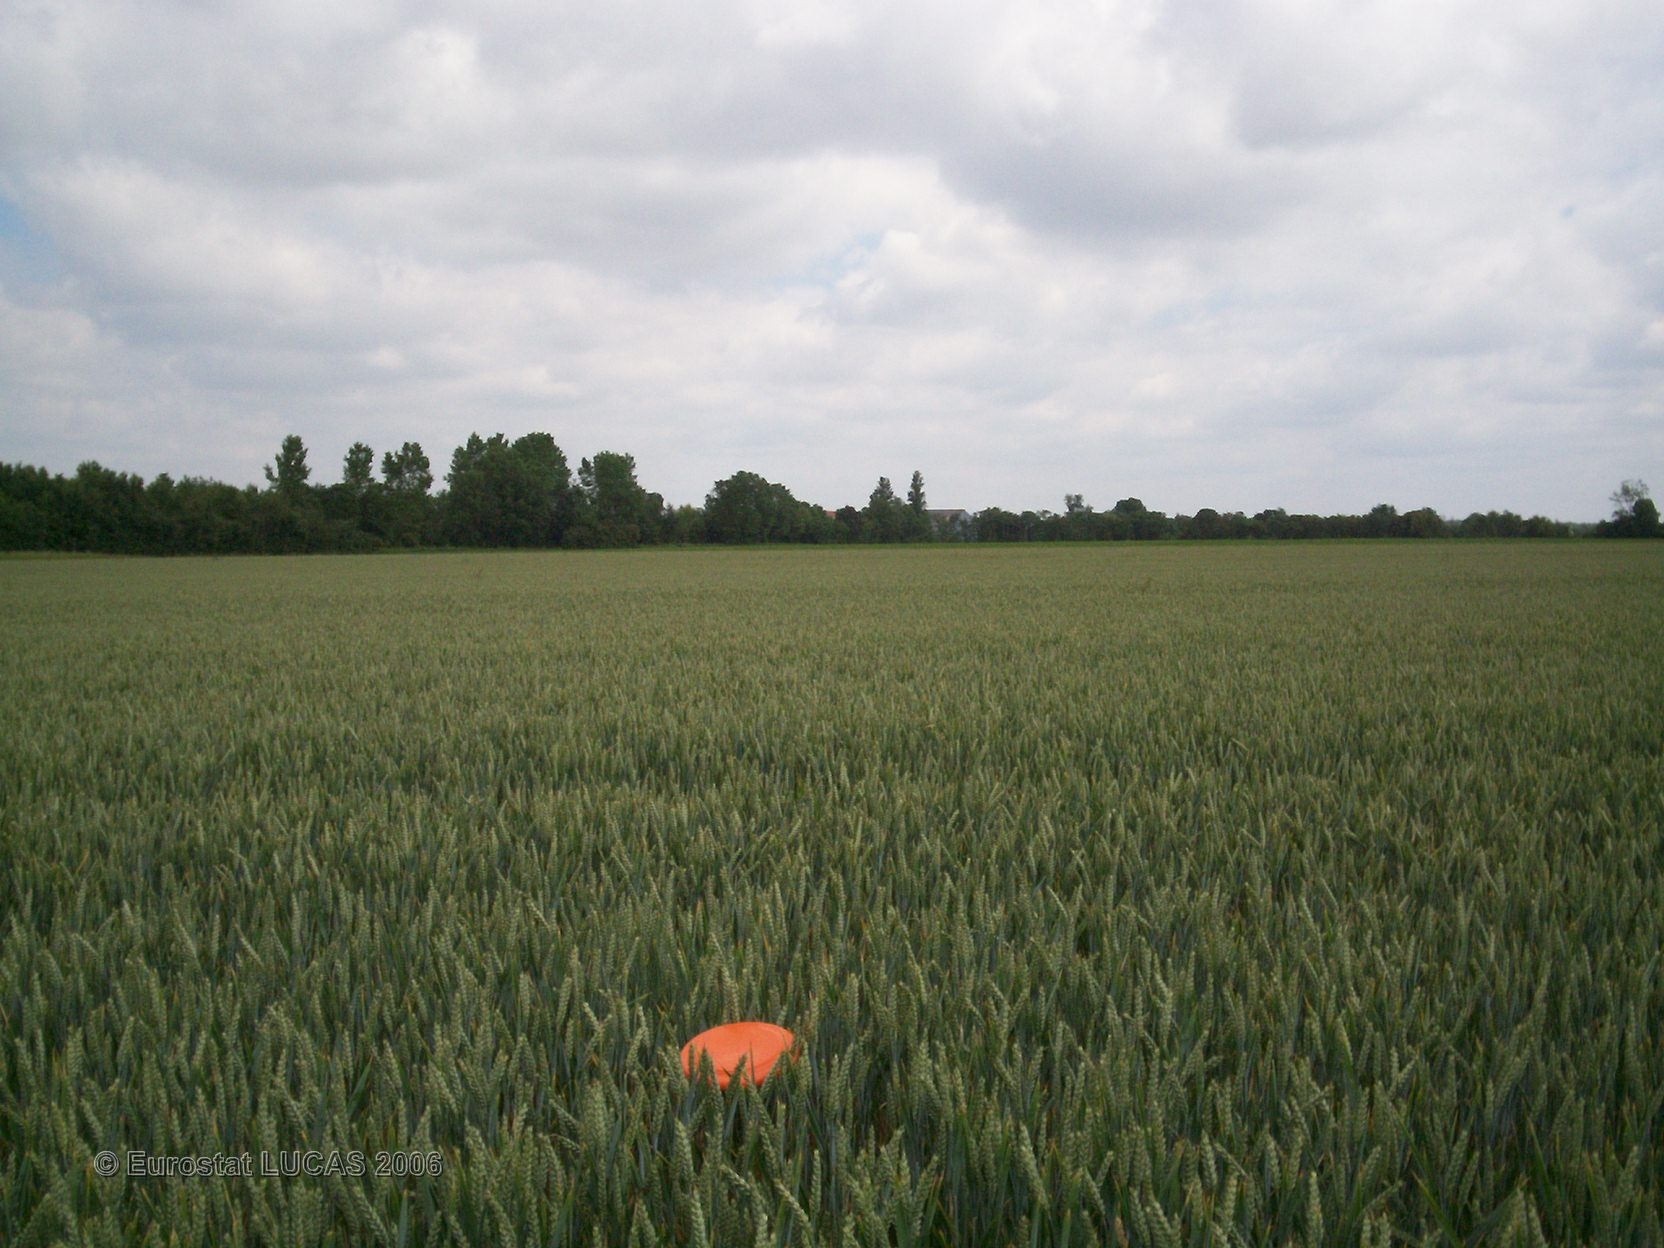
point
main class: Cropland
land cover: Common wheat
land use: Agriculture (excluding fallow land and kitchen gardens)
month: June
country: FR
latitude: 46.1539
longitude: -0.9188
